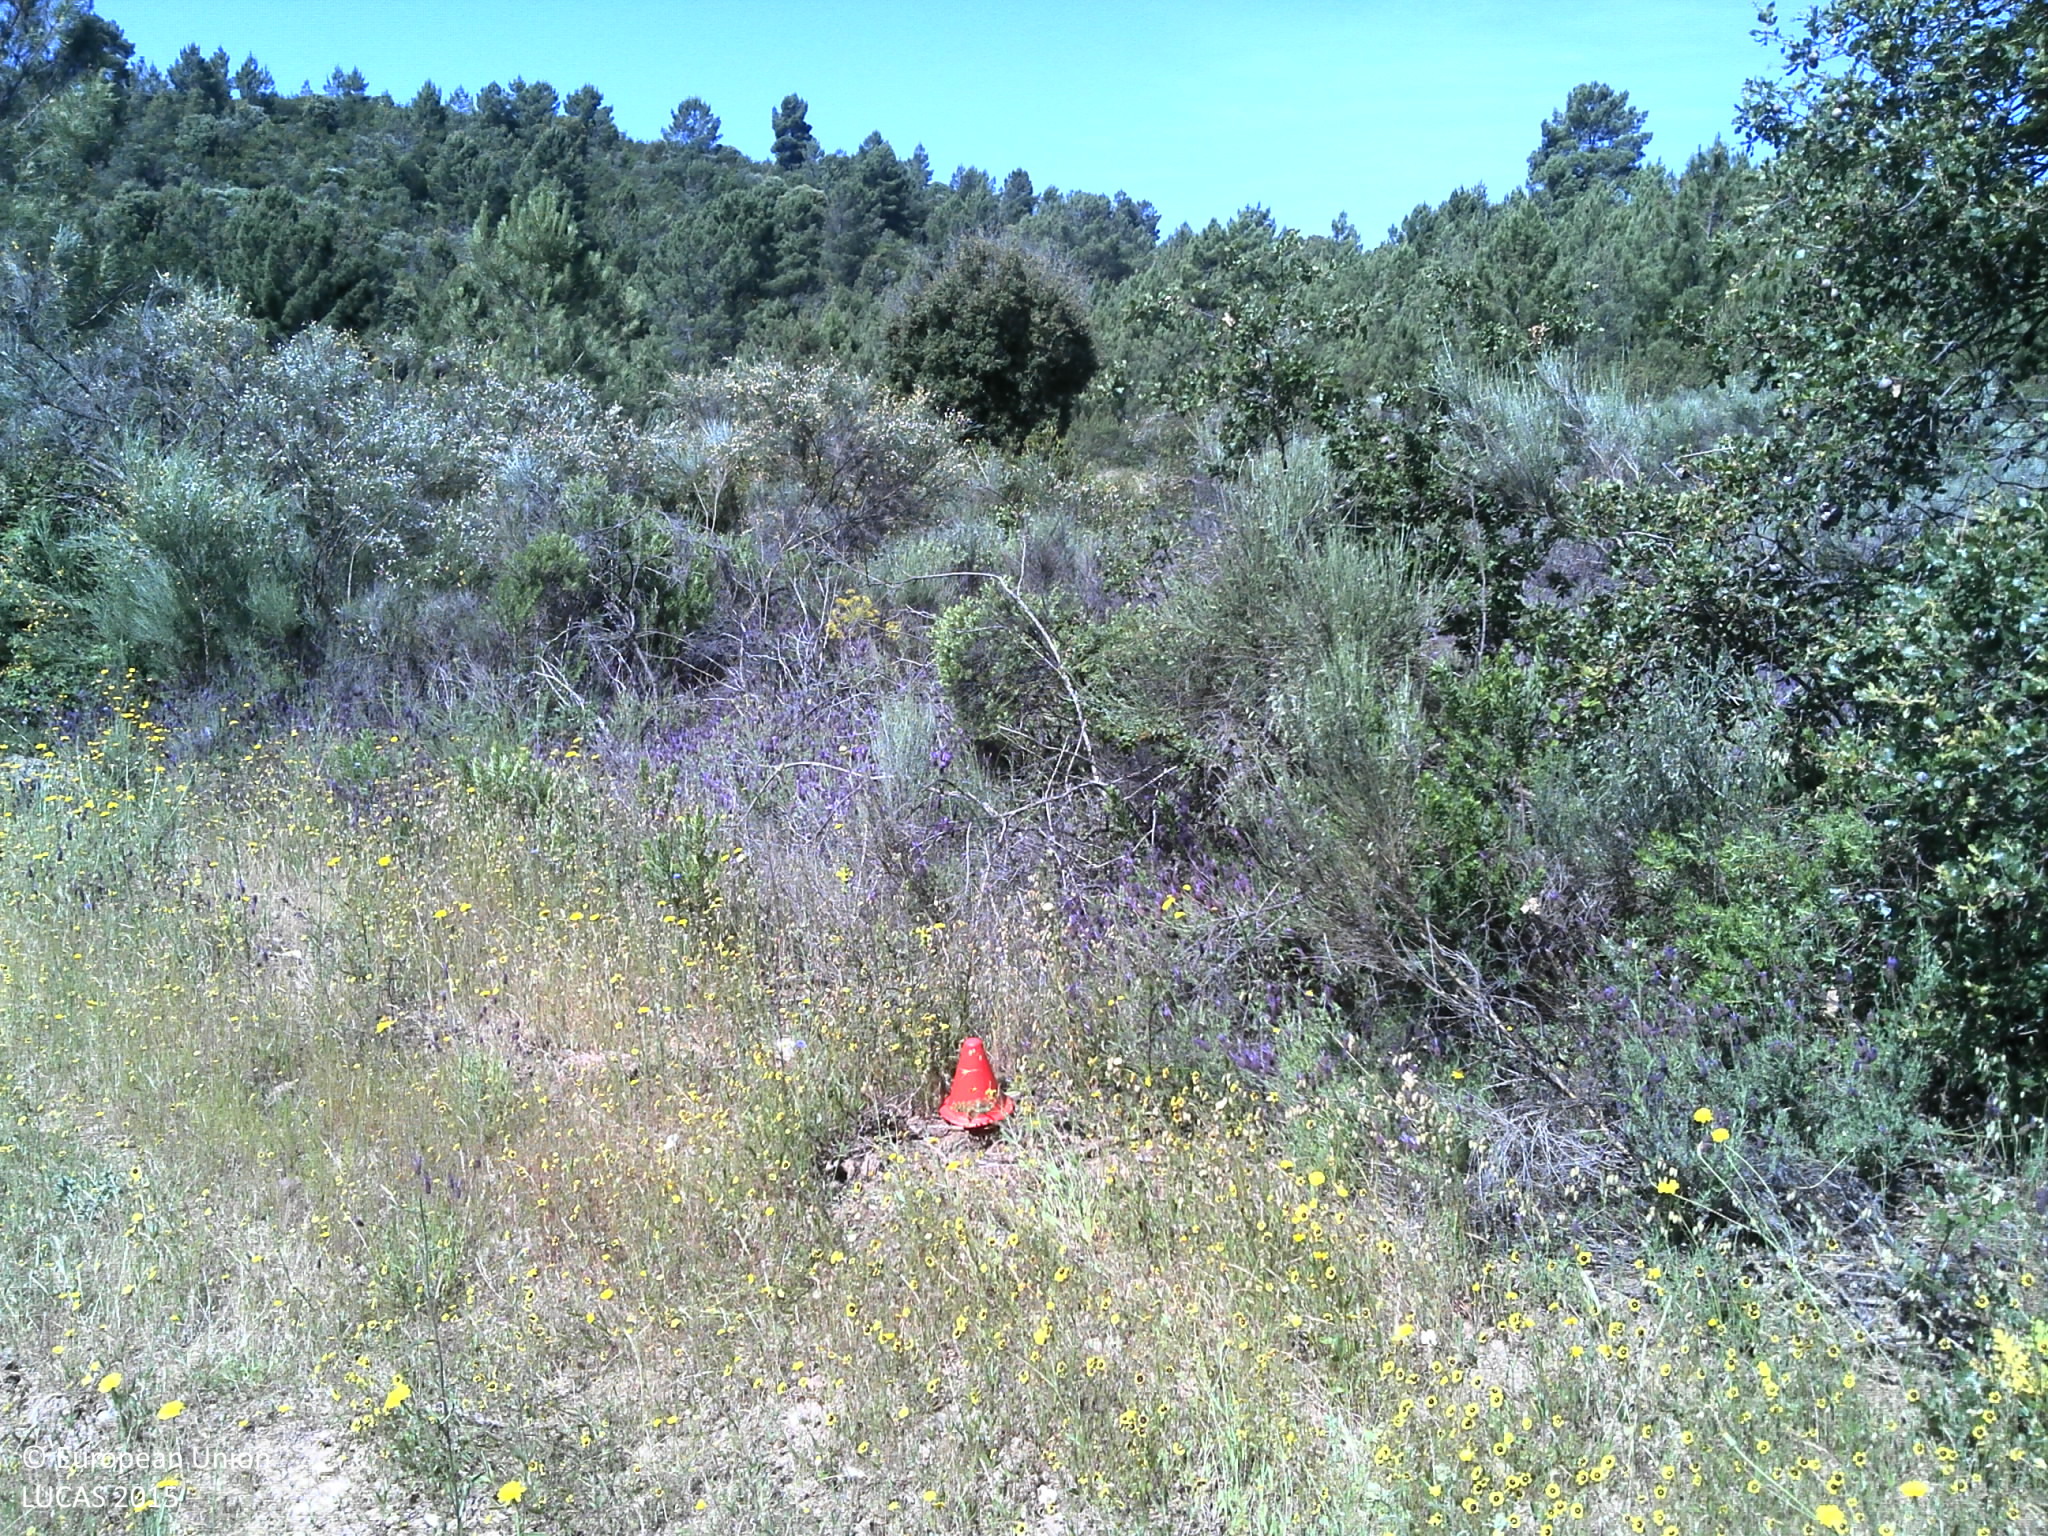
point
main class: Shrubland
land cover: Shrubland with sparse tree cover
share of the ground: > 75 %
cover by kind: shrubs 95 %, broadleaved forest trees 5 %
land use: Abandoned areas
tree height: > 5 m
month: May
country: PT
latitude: 41.1218
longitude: -6.8391
